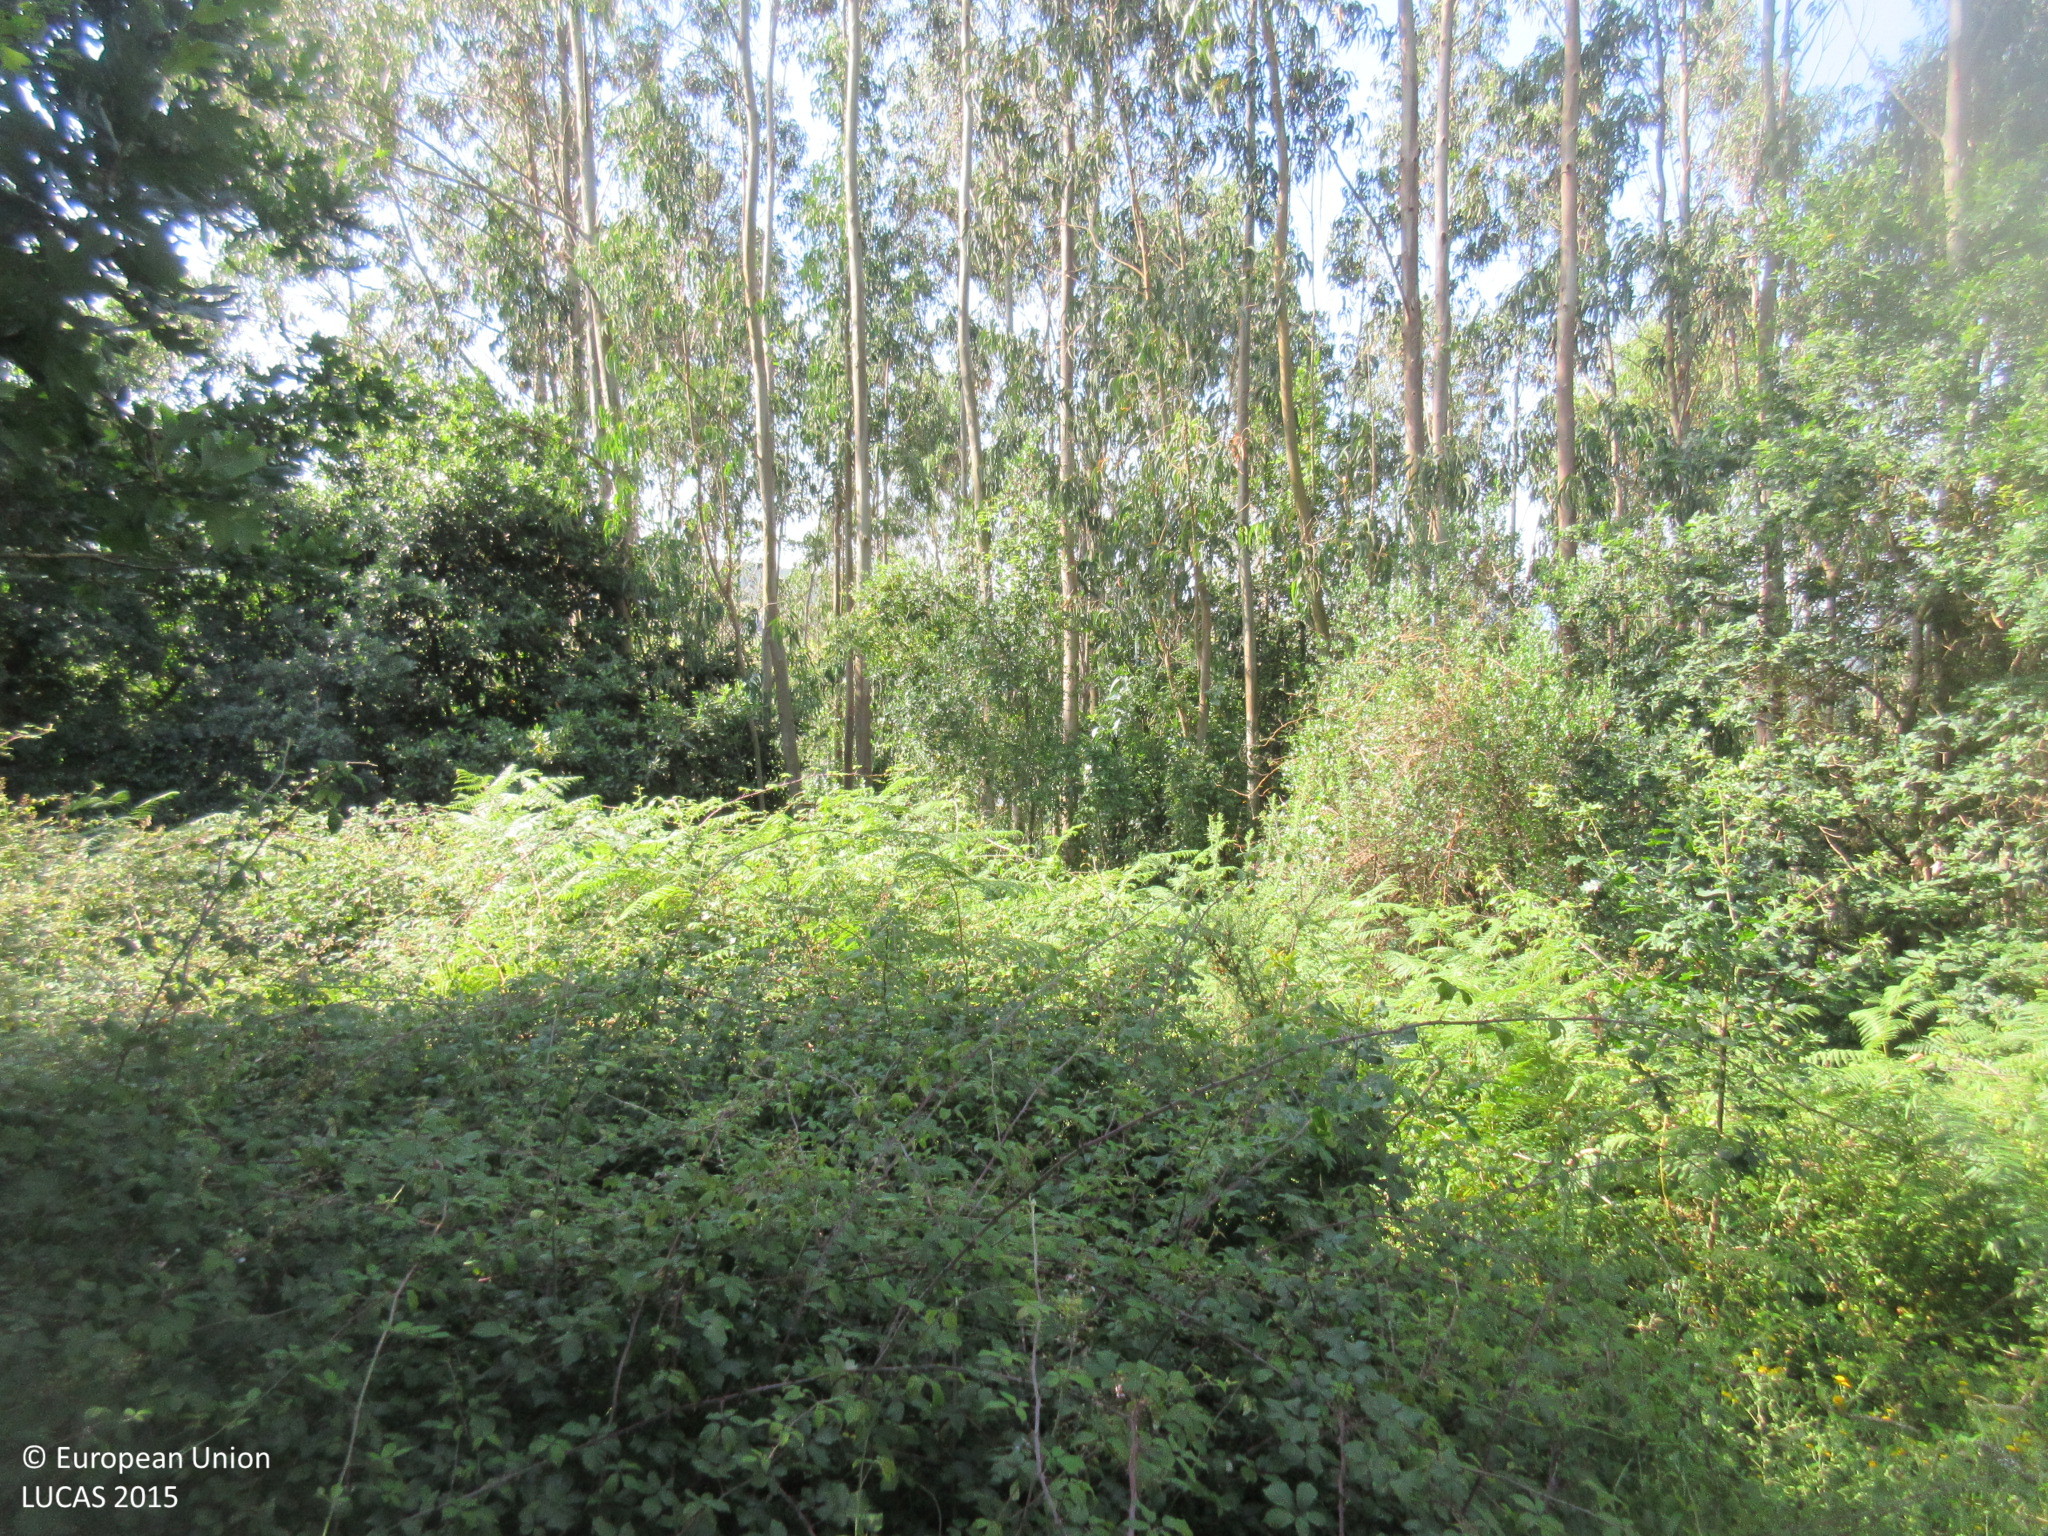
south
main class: Woodland
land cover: Broadleaved woodland
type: exotic forest
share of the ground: > 75 %
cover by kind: broadleaved forest trees 90 %, shrubs 10 %
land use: Forestry
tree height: > 5 m
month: July
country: ES
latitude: 43.4040
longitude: -3.9423
